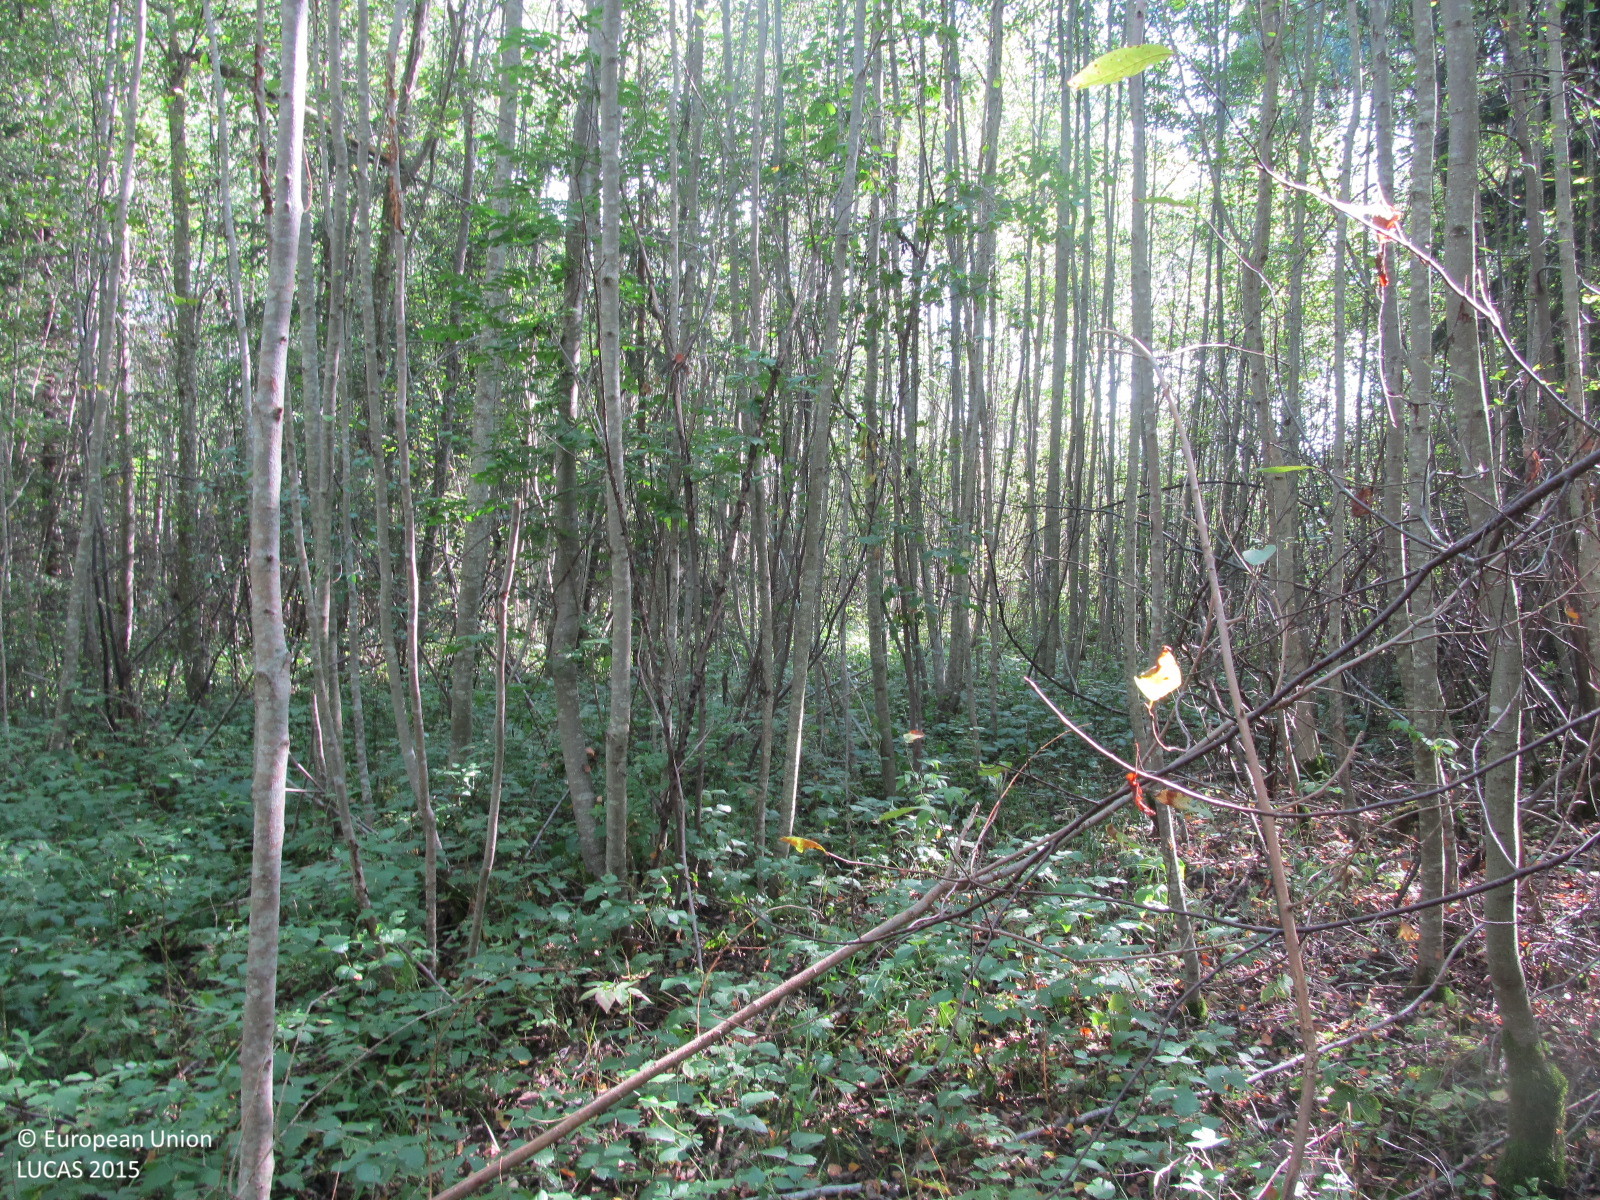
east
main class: Woodland
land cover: Broadleaved woodland
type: non-riverine alder, birch or aspen forest
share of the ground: > 75 %
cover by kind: broadleaved forest trees 85 %, shrubs 5 %, herbaceous plants 5 %, unconsolidated bare surface 5 %
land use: Forestry
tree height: > 5 m
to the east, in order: Broadleaved woodland; Other mixed woodland; Shrubland with sparse tree cover; Ditches and canals; Paved roads, cycling and walking lanes; Ditches and canals; Shrubland with sparse tree cover; Broadleaved woodland
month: September
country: LT
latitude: 56.0868
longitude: 23.3648
